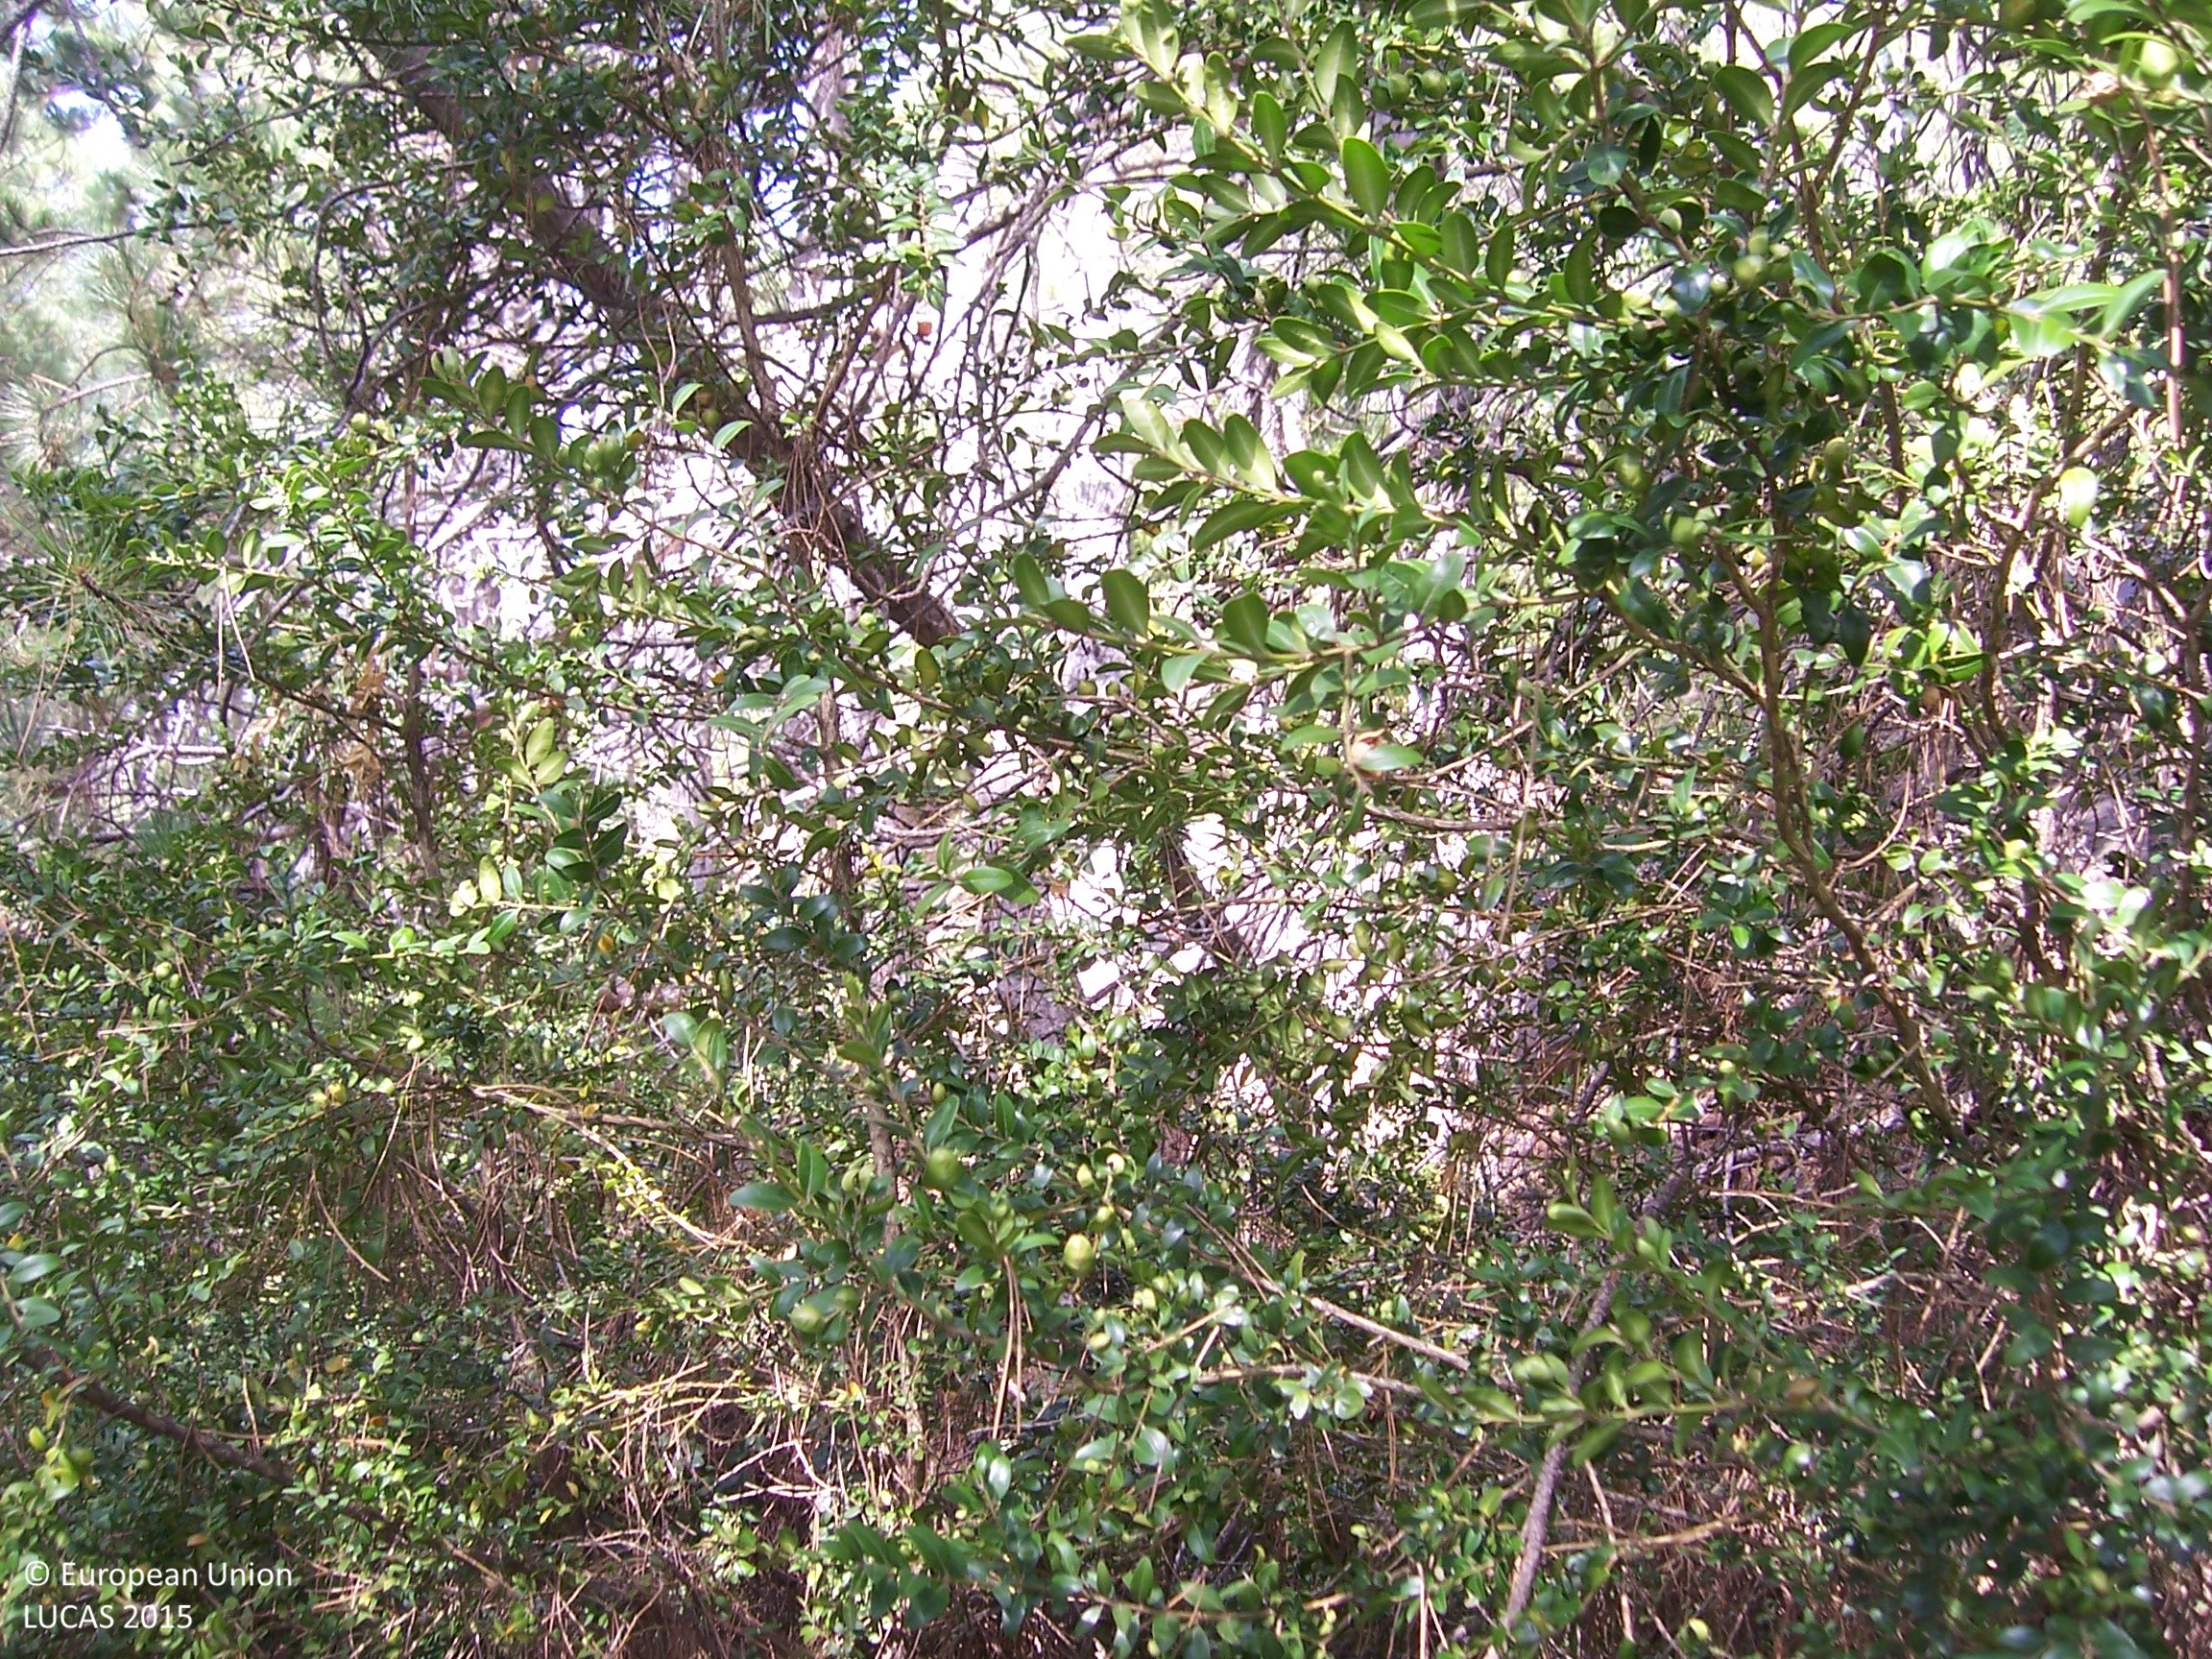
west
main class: Woodland
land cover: Pine dominated coniferous woodland
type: coniferous forest of the mediterranean region
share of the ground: > 75 %
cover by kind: coniferous forest trees 100 %
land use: Forestry
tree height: > 5 m
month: August
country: ES
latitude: 42.5856
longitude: -0.4448
